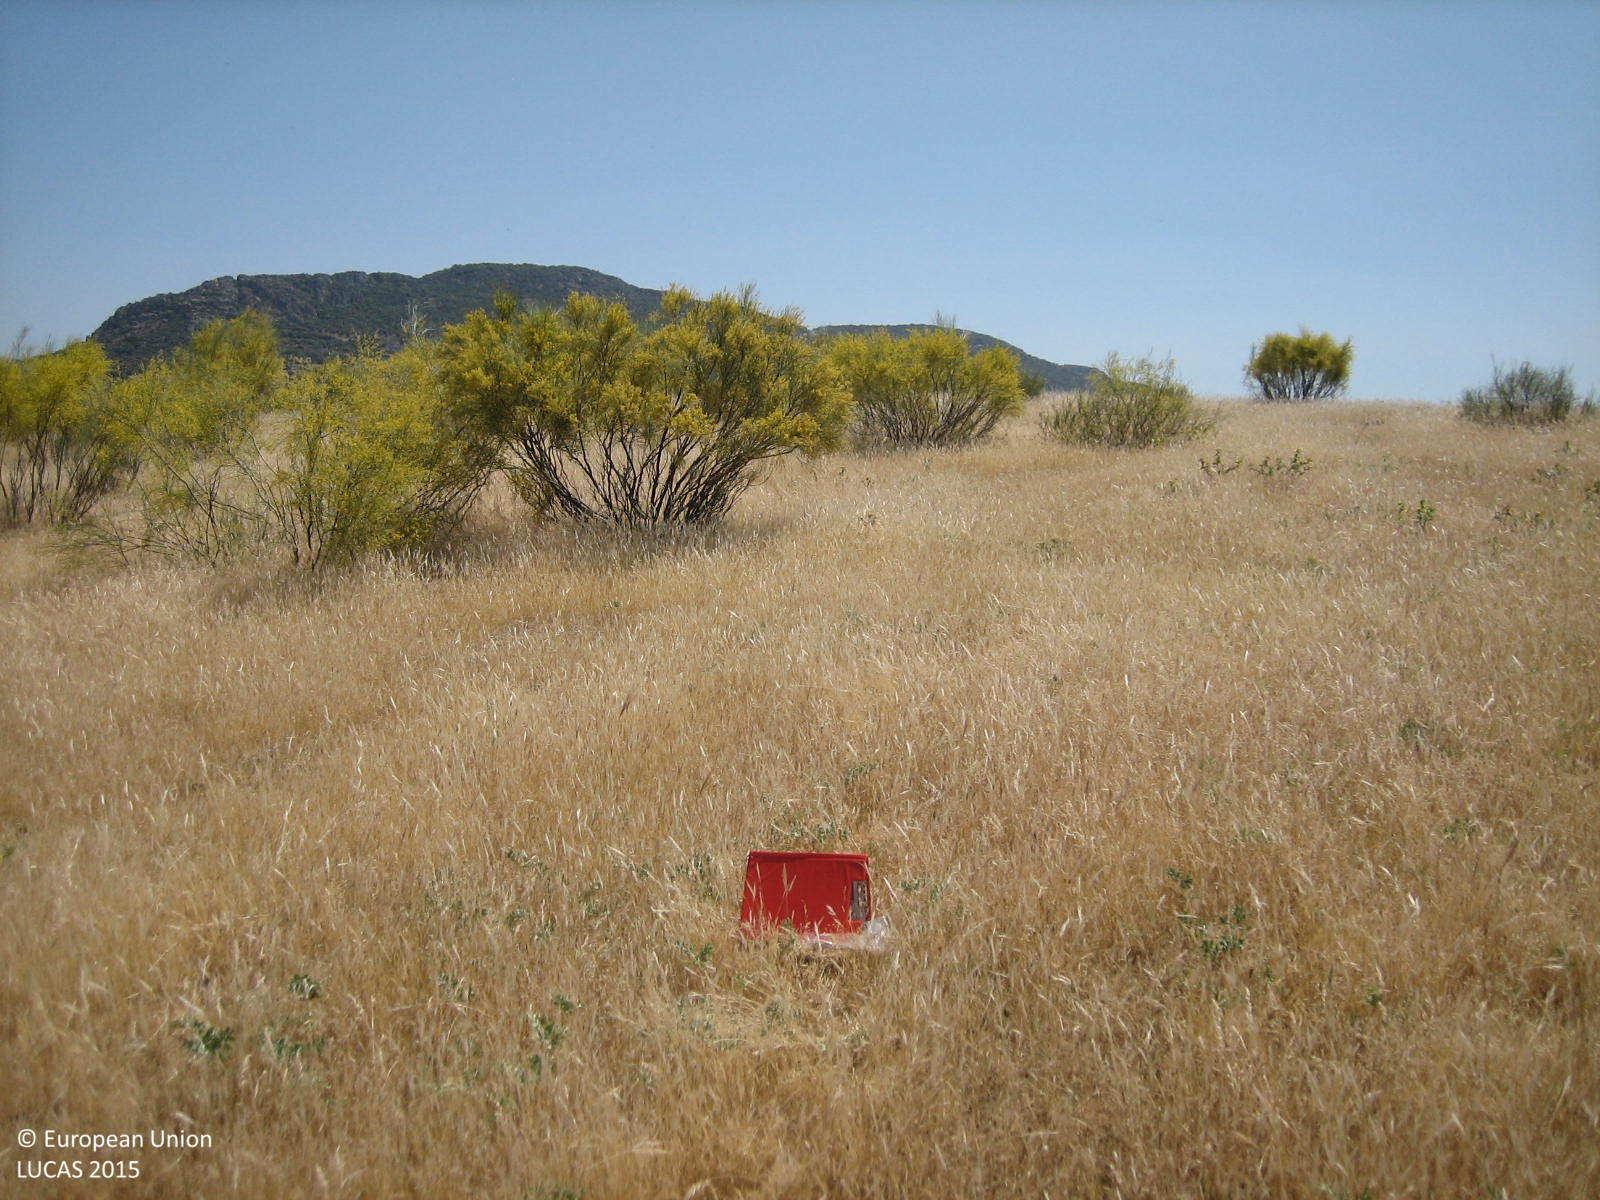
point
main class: Grassland
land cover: Grassland with sparse tree/shrub cover
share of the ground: > 75 %
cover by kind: herbaceous plants 90 %, broadleaved forest trees 5 %, shrubs 5 %
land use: Agriculture (excluding fallow land and kitchen gardens)
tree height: < 5 m
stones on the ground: < 10 %
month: May
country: ES
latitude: 38.9167
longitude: -5.1568
